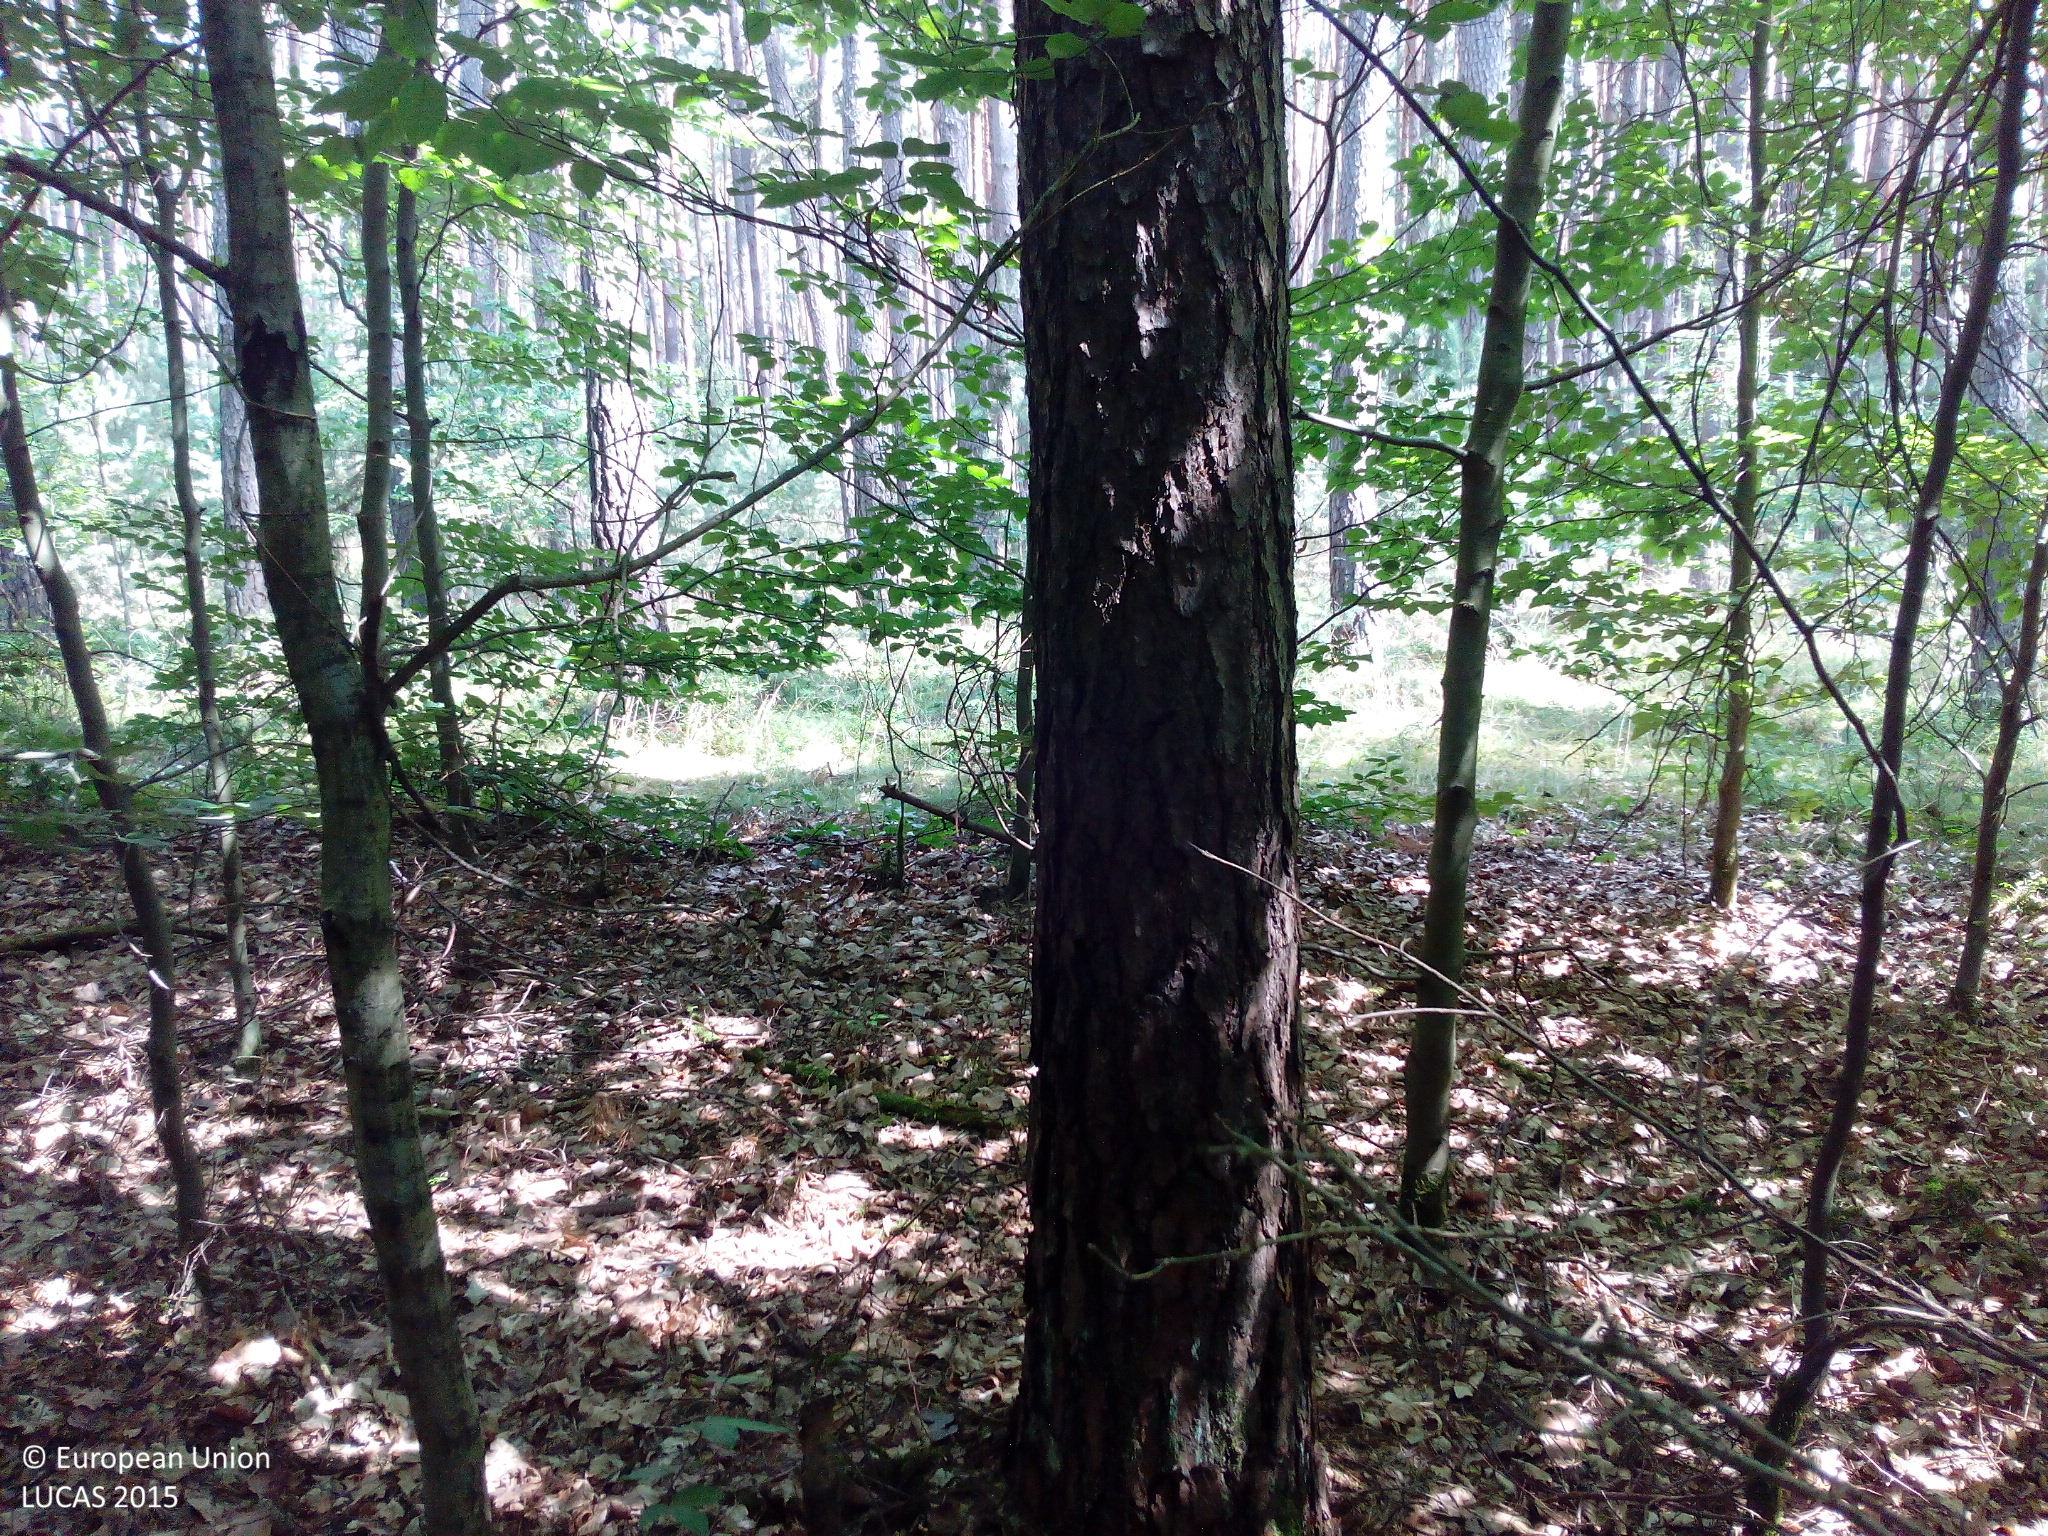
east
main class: Woodland
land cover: Pine dominated mixed woodland
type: hemiboreal forest and nemoral coniferous forest and mixed broadleaved-coniferous forest
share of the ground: > 75 %
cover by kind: broadleaved forest trees 60 %, coniferous forest trees 35 %, unconsolidated bare surface 5 %
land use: Forestry
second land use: Amenities, museums, leisure
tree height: > 5 m
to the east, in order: Pine dominated mixed woodland; Tracks; Pine dominated coniferous woodland; Tracks; Pine dominated coniferous woodland; Tracks; Pine dominated mixed woodland; Tracks; Pine dominated mixed woodland; Tracks; Pine dominated coniferous woodland; Tracks; Pine dominated mixed woodland; Pine dominated coniferous woodland; Tracks; Pine dominated coniferous woodland
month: July
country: DE
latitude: 49.6227
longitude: 10.9548
